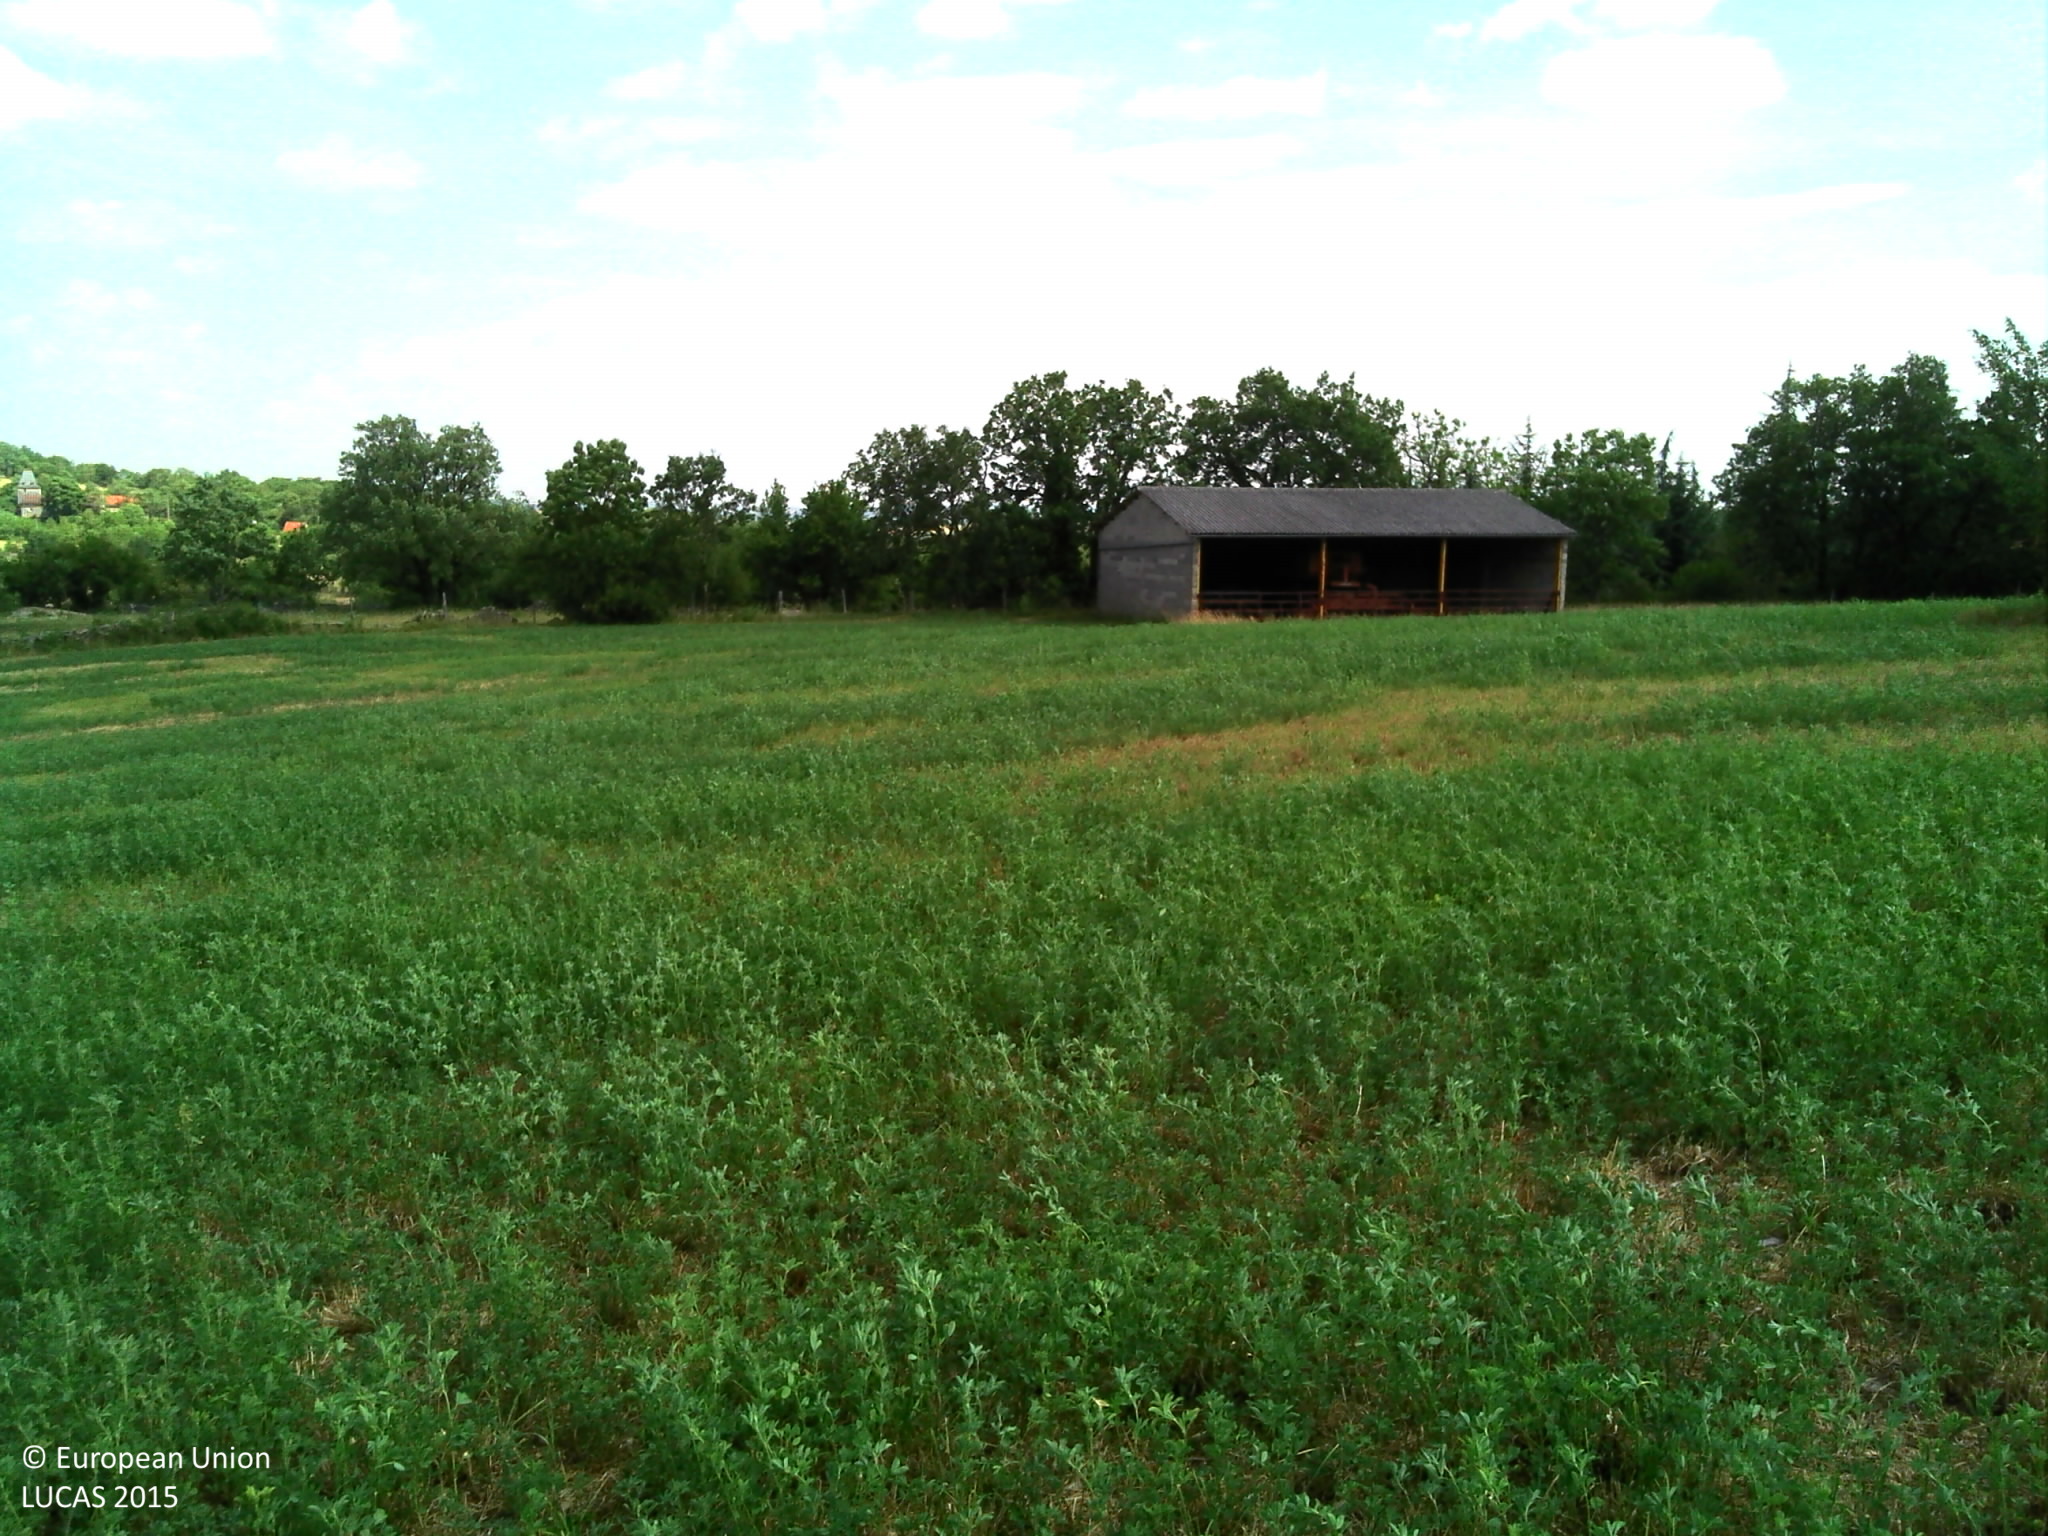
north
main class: Cropland
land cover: Lucerne
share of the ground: > 75 %
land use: Agriculture (excluding fallow land and kitchen gardens)
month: June
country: FR
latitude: 44.4320
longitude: 1.8977
